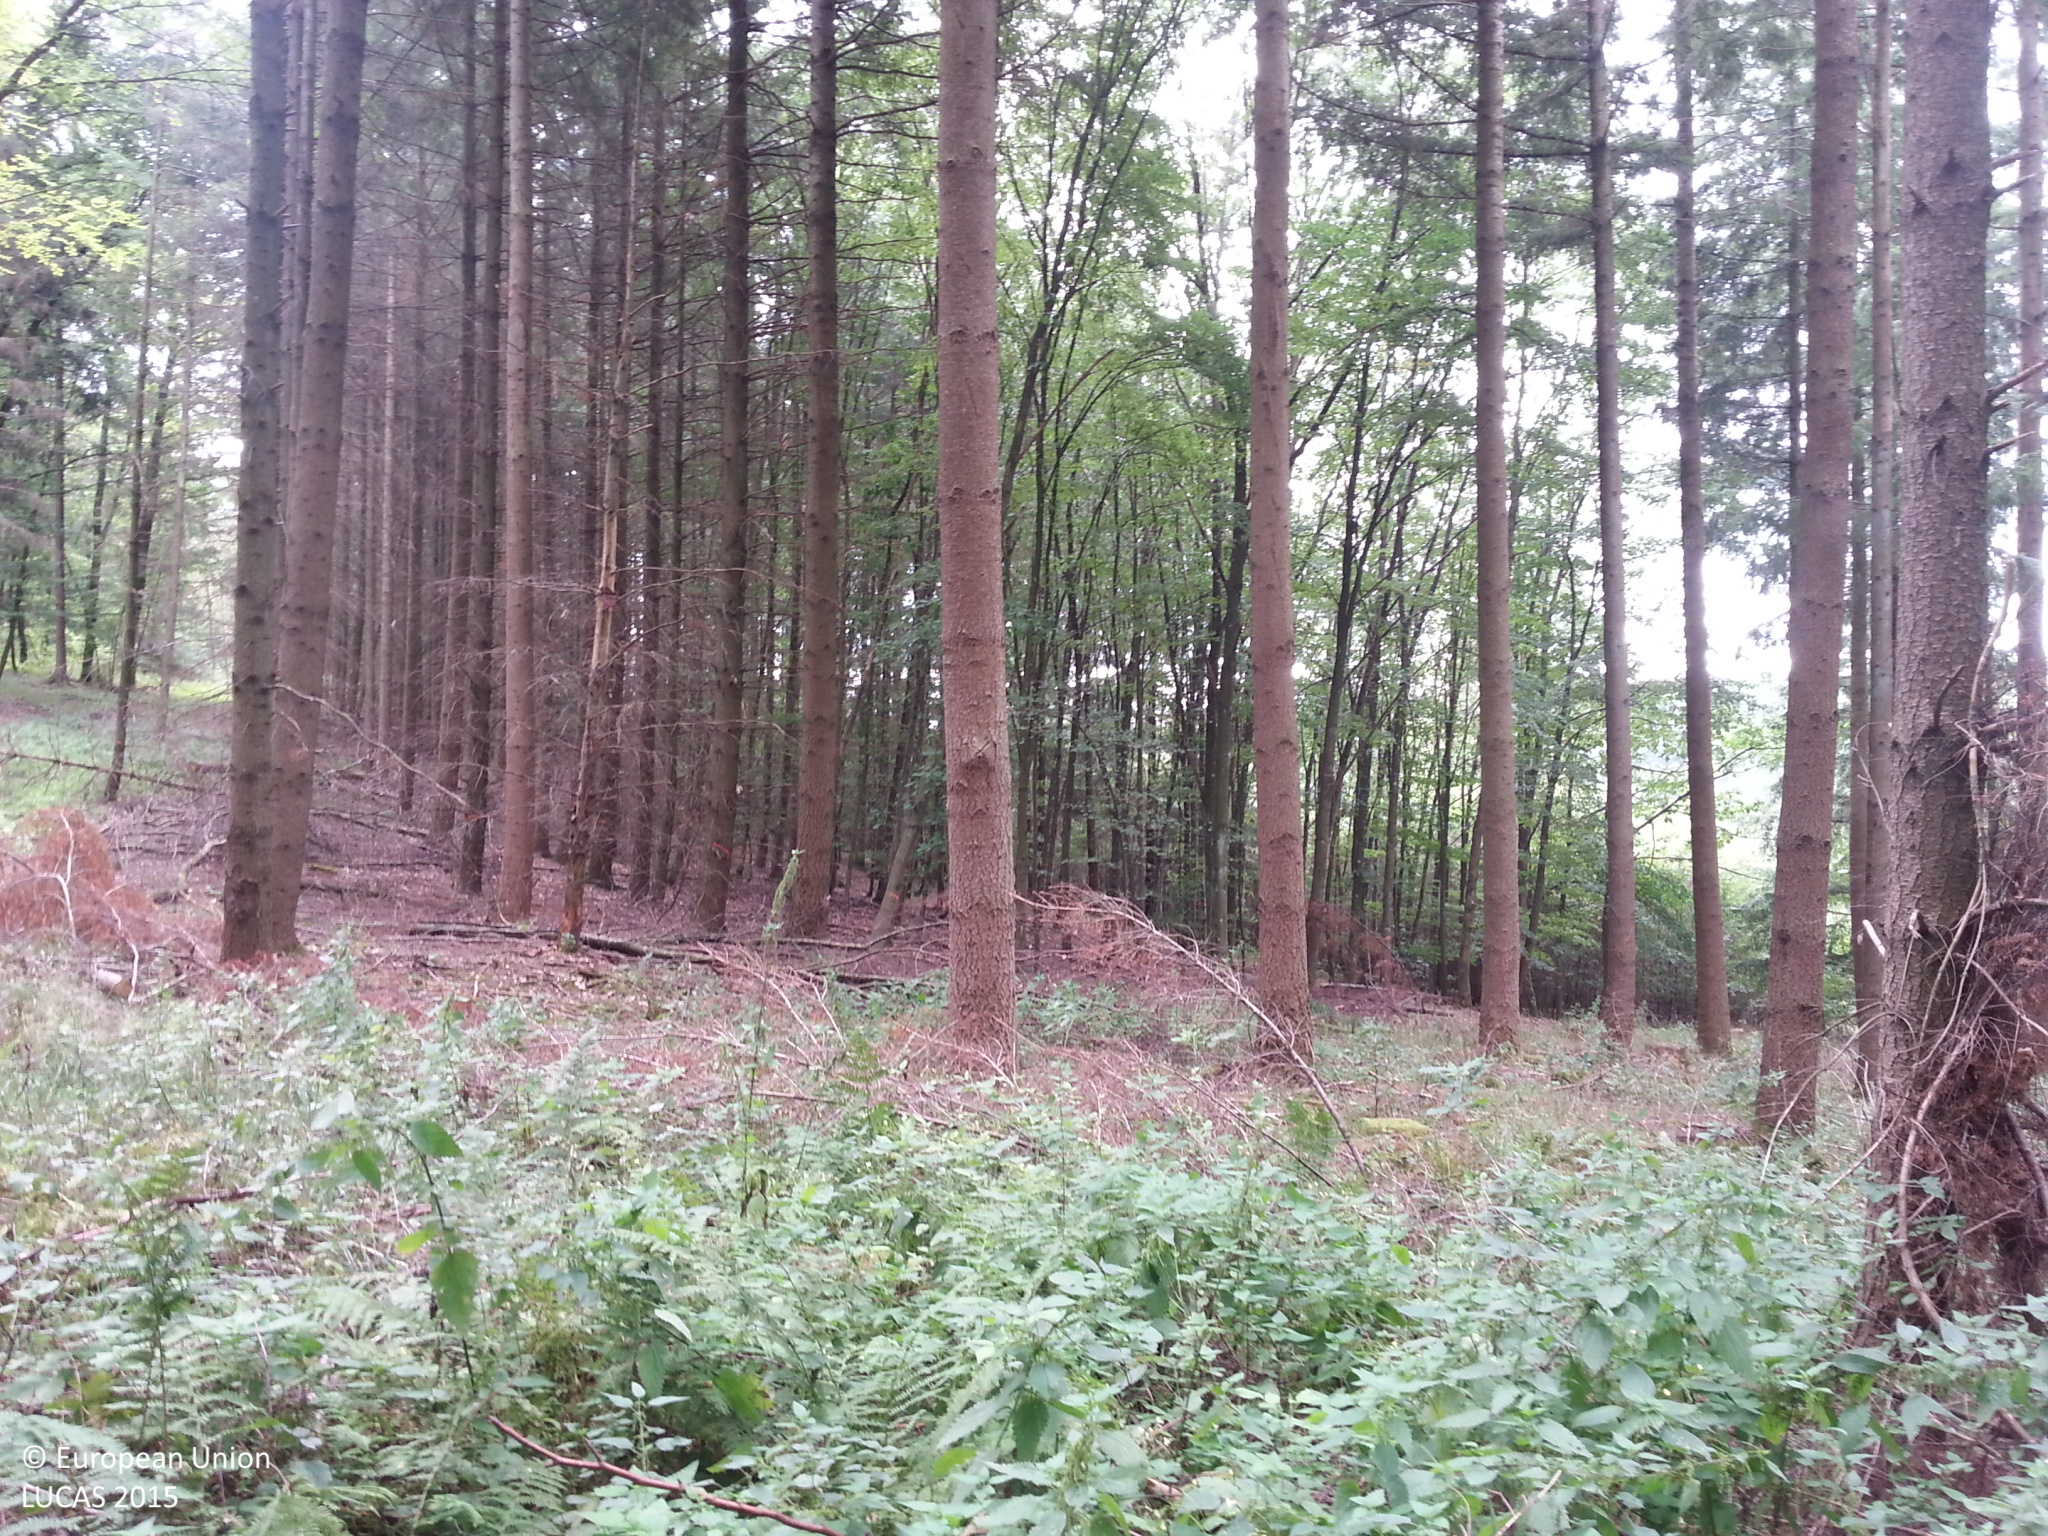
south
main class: Woodland
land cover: Spruce dominated coniferous woodland
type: boreal forest
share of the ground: > 75 %
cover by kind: coniferous forest trees 65 %, broadleaved forest trees 15 %, lichens and mosses 10 %, herbaceous plants 5 %, unconsolidated bare surface 5 %
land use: Forestry
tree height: > 5 m
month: September
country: DE
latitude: 49.4453
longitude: 9.4071
